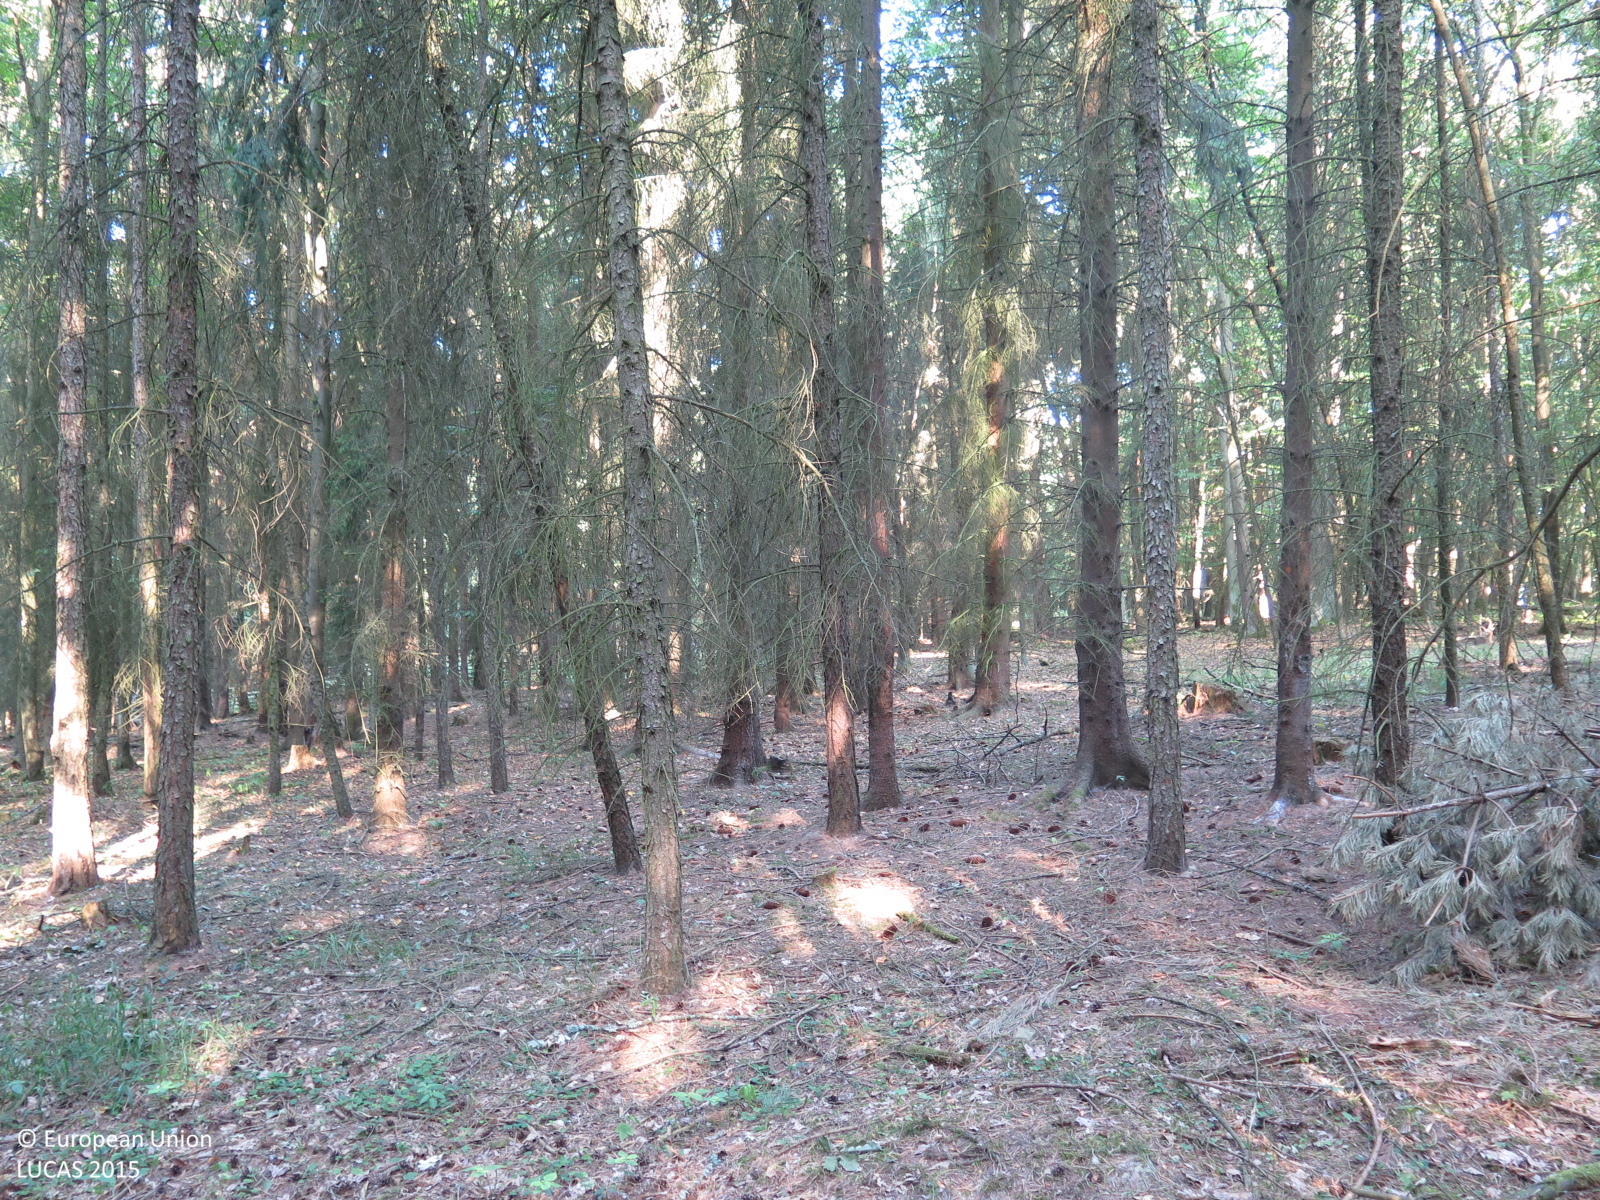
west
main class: Woodland
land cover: Other coniferous woodland
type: hemiboreal forest and nemoral coniferous forest and mixed broadleaved-coniferous forest
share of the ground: > 75 %
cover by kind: coniferous forest trees 90 %, broadleaved forest trees 5 %, herbaceous plants 5 %
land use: Forestry
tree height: > 5 m
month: August
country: CZ
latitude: 50.0835
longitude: 13.8439
